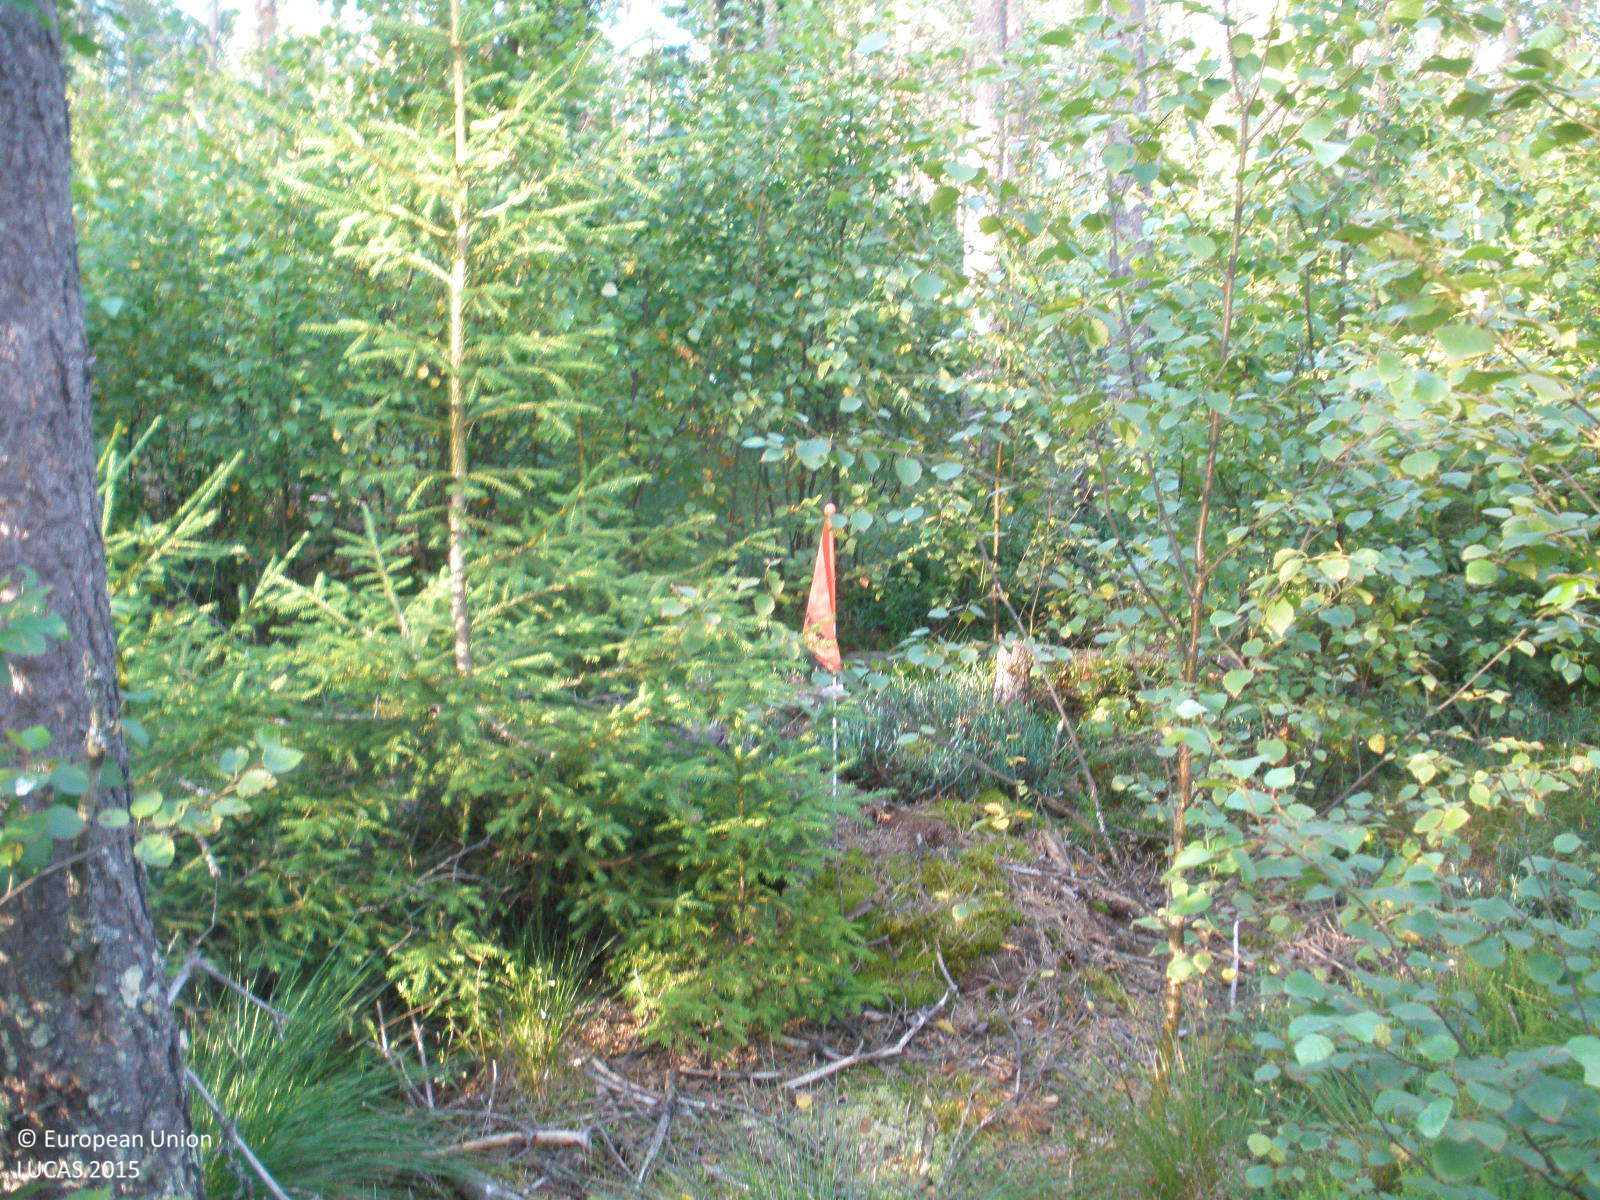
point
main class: Woodland
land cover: Pine dominated coniferous woodland
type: boreal forest
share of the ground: > 75 %
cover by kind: coniferous forest trees 70 %, broadleaved forest trees 15 %, shrubs 5 %, herbaceous plants 5 %, lichens and mosses 5 %
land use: Forestry
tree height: > 5 m
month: August
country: FI
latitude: 60.9877
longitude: 24.8416
